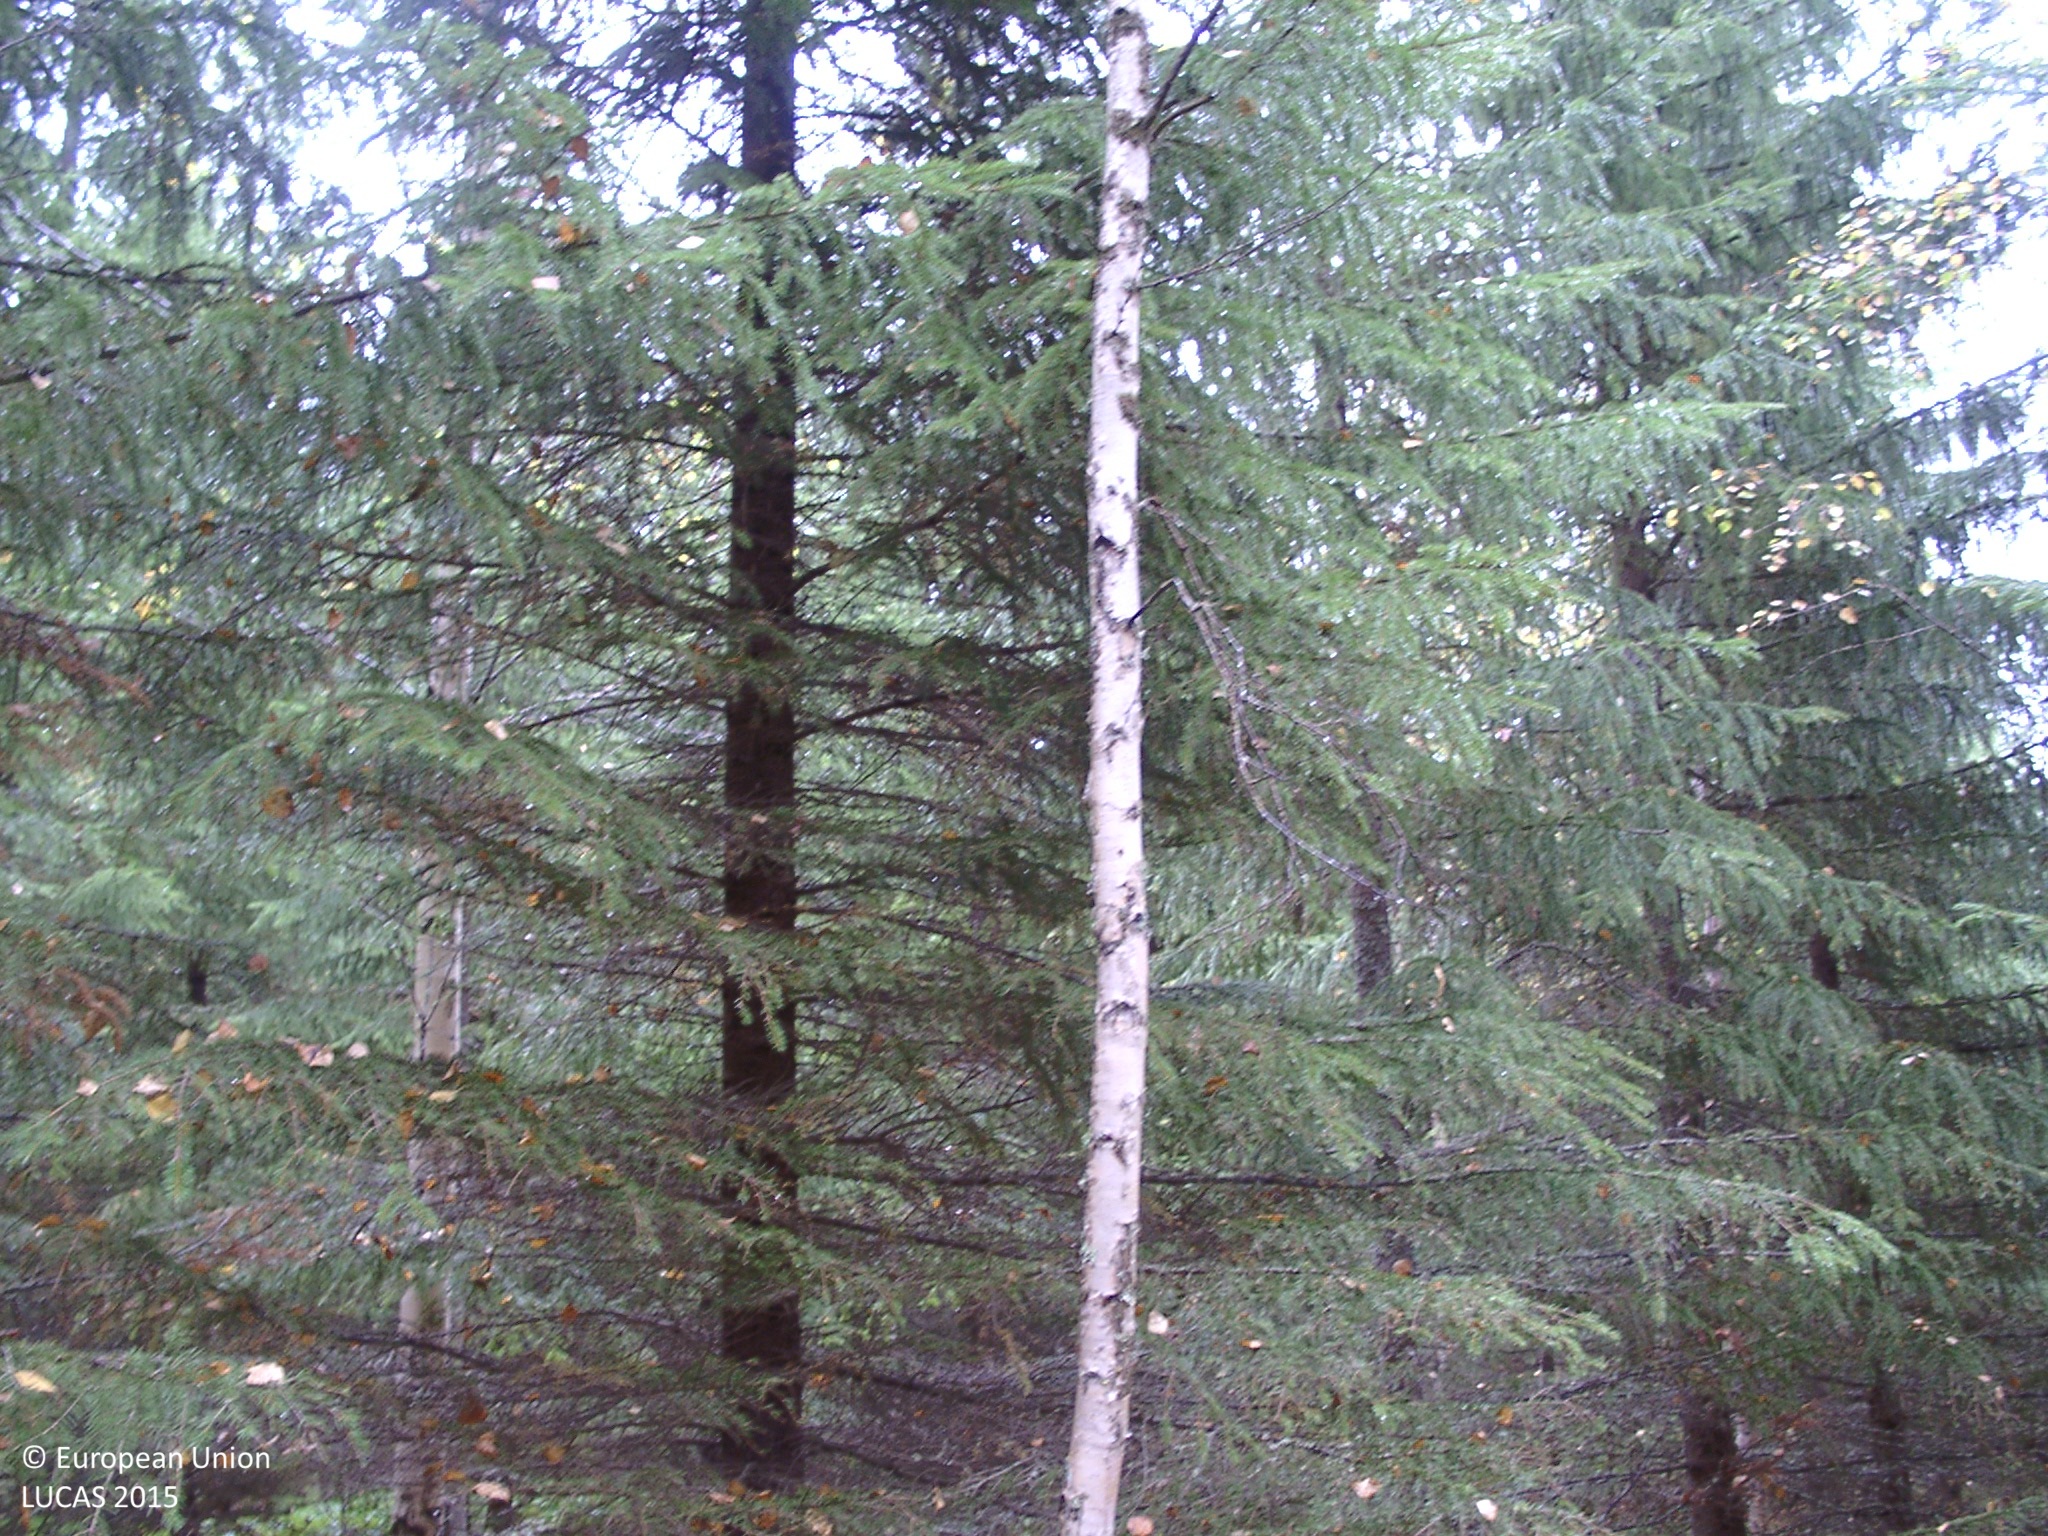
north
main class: Woodland
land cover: Spruce dominated mixed woodland
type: boreal forest
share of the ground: > 75 %
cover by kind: coniferous forest trees 60 %, broadleaved forest trees 25 %, herbaceous plants 5 %, lichens and mosses 5 %
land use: Forestry
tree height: > 5 m
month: September
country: FI
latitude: 62.6211
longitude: 25.6090
